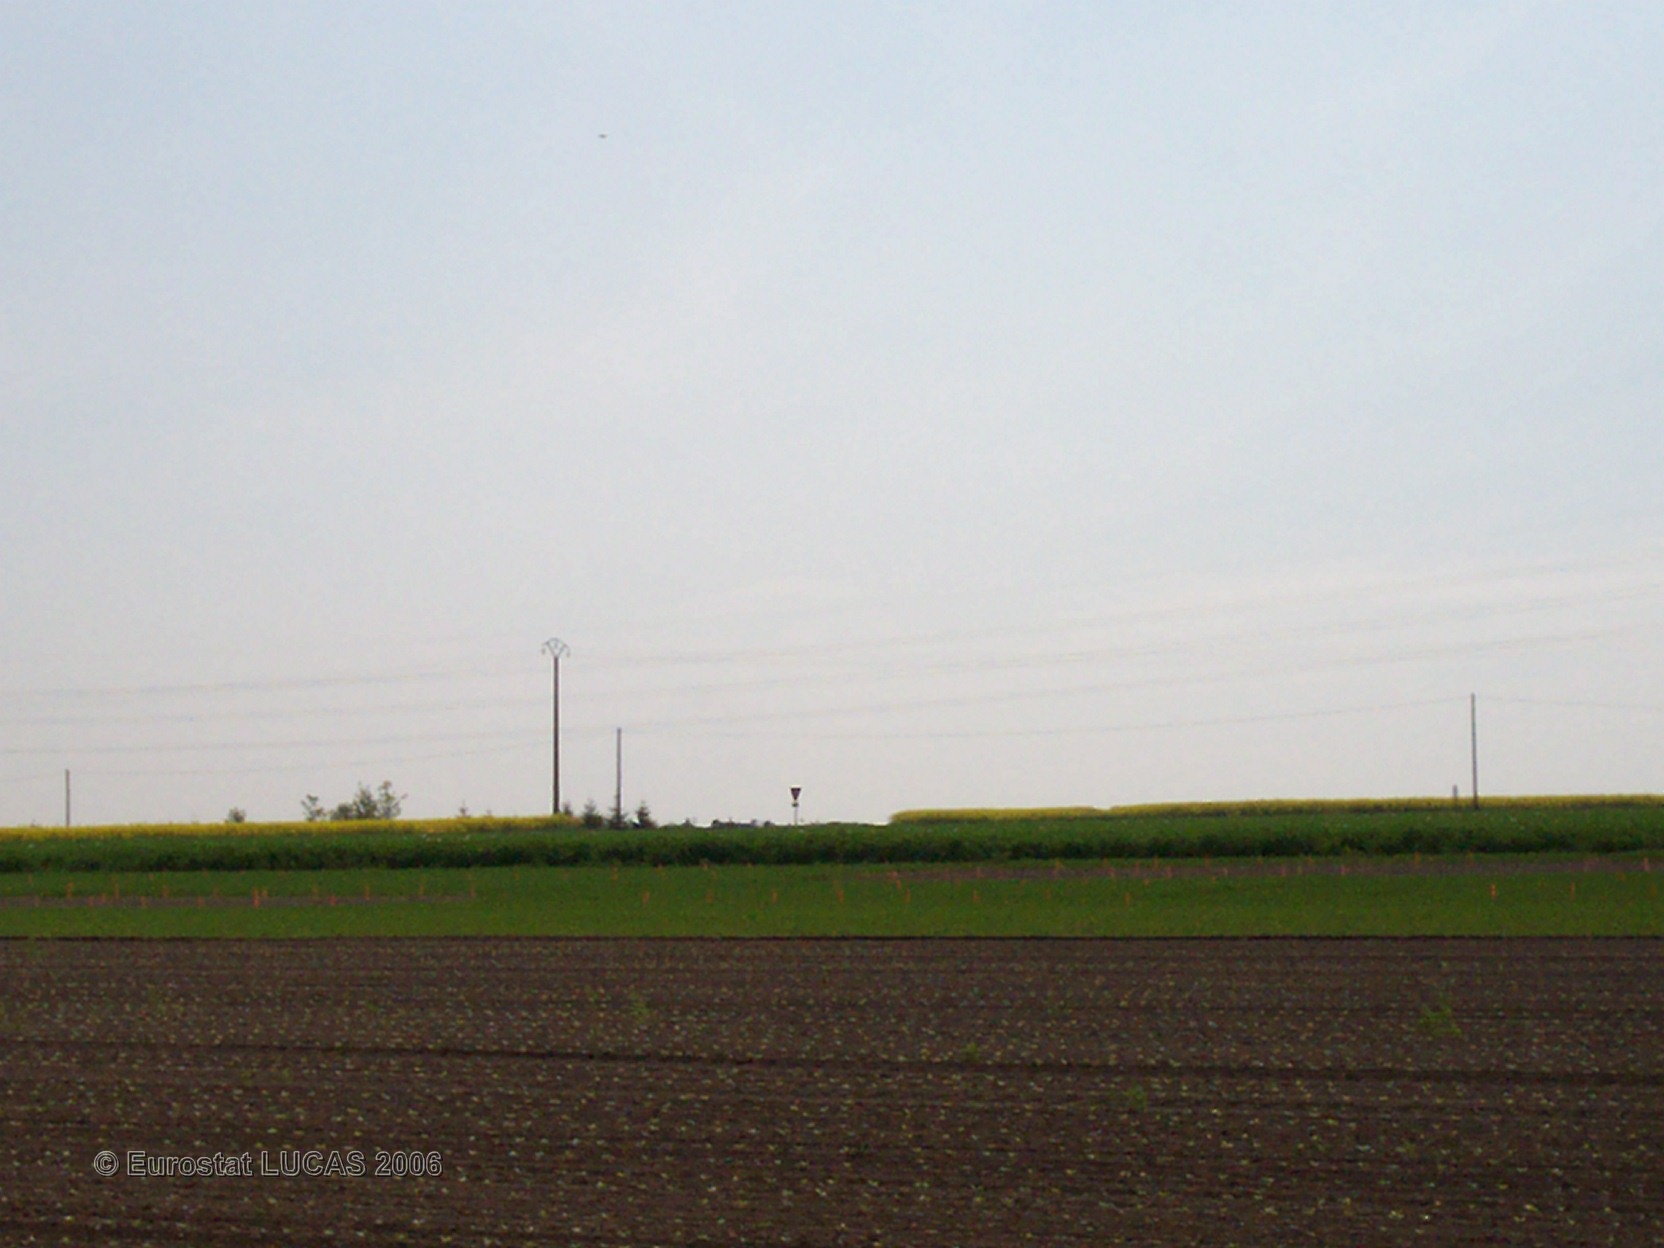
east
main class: Cropland
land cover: Sugar beet
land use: Agriculture (excluding fallow land and kitchen gardens)
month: May
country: FR
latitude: 49.0578
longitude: 4.4542
